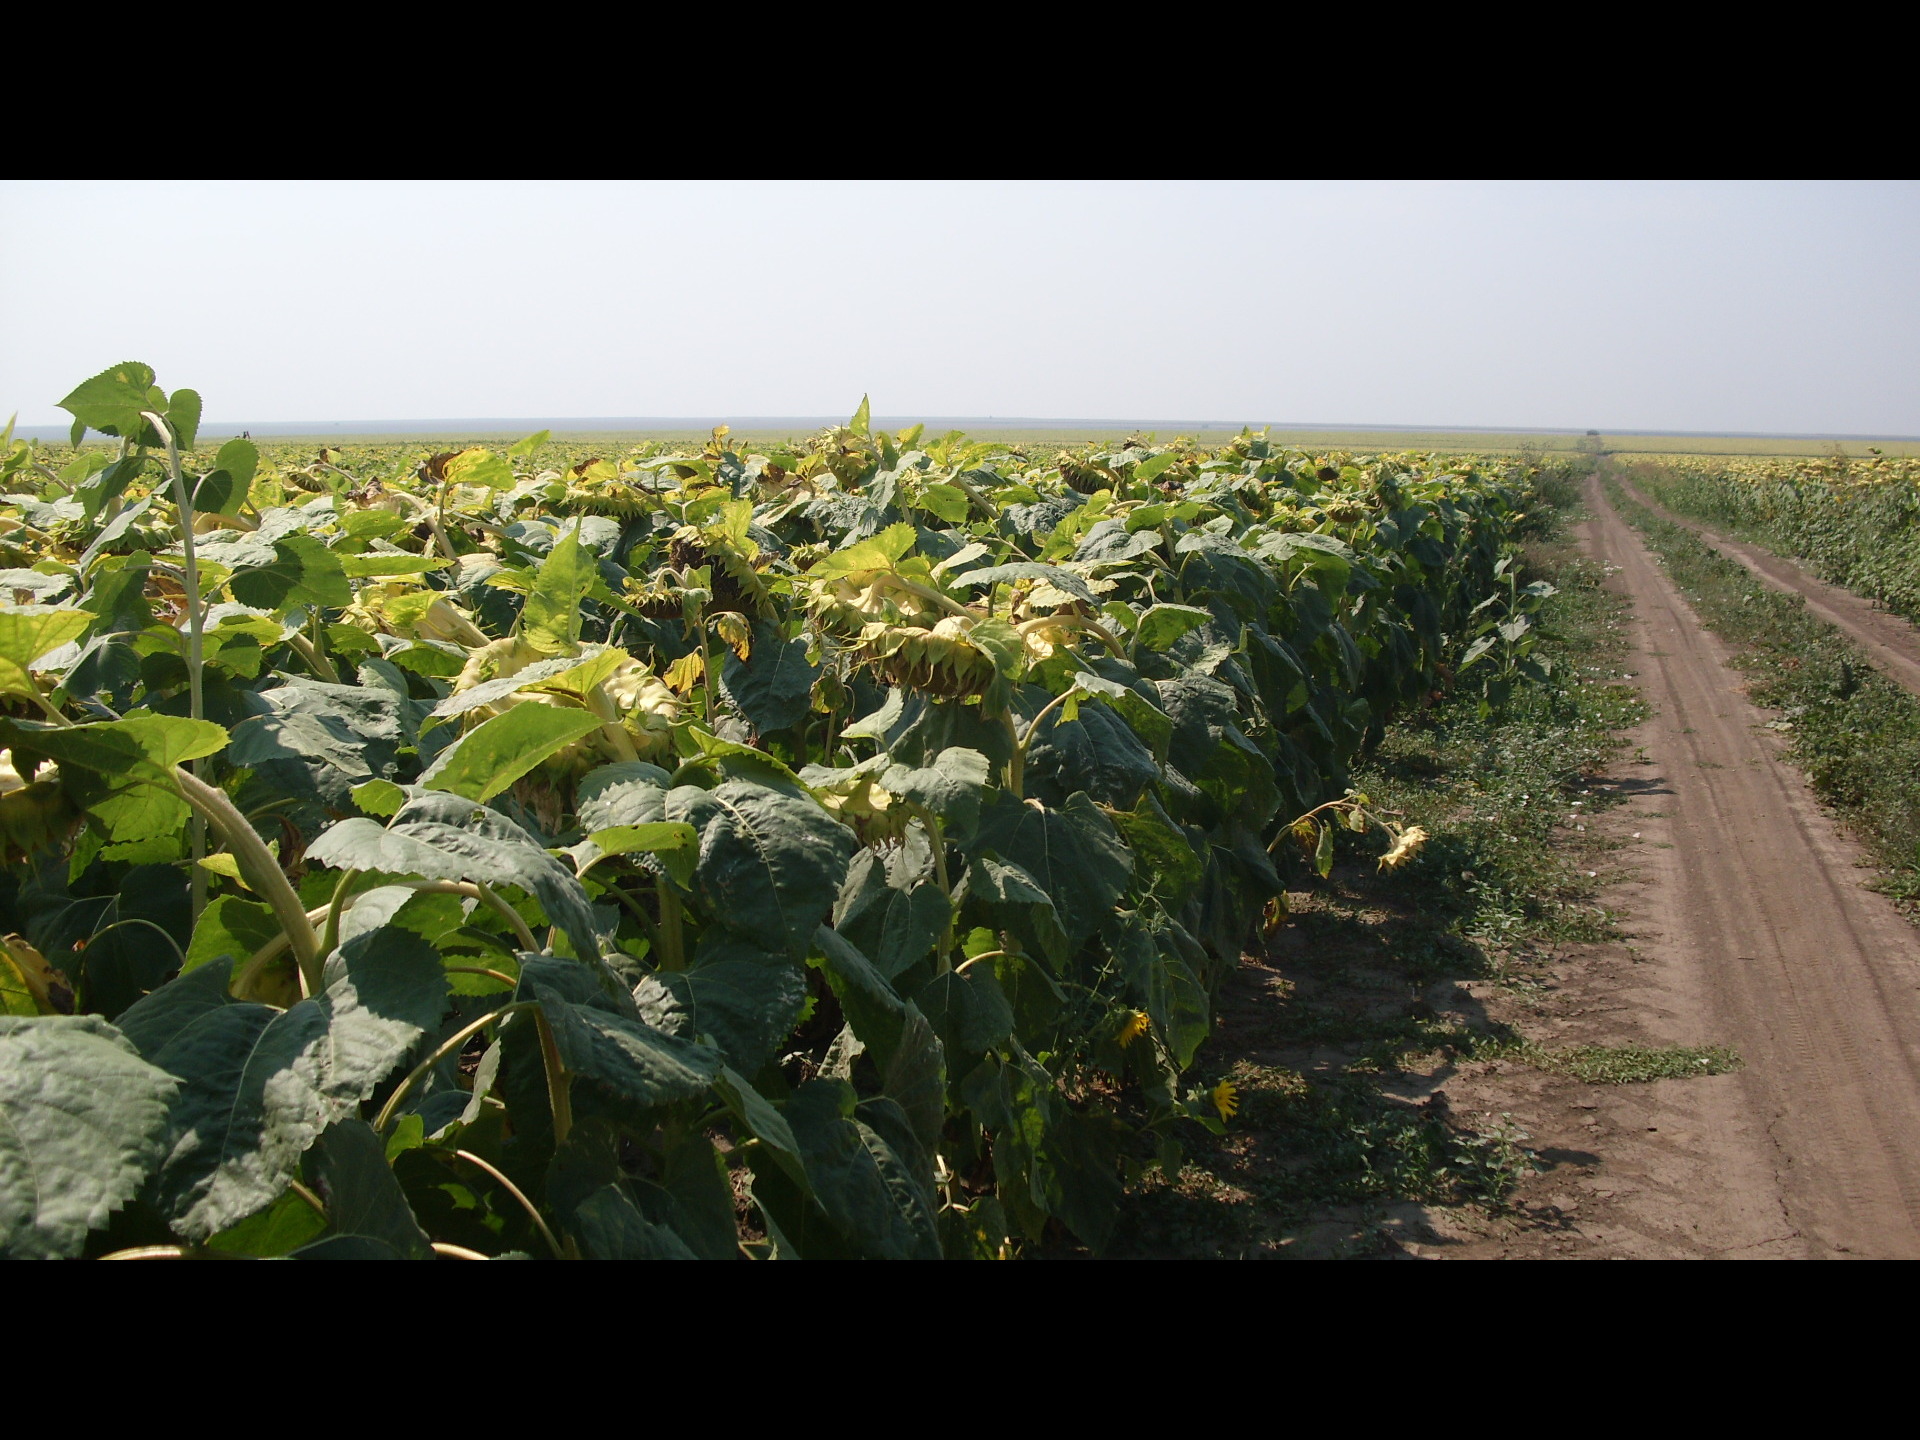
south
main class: Cropland
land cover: Sunflower
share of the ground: > 75 %
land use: Agriculture (excluding fallow land and kitchen gardens)
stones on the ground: < 10 %
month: July
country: BG
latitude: 43.7531
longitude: 23.5224
